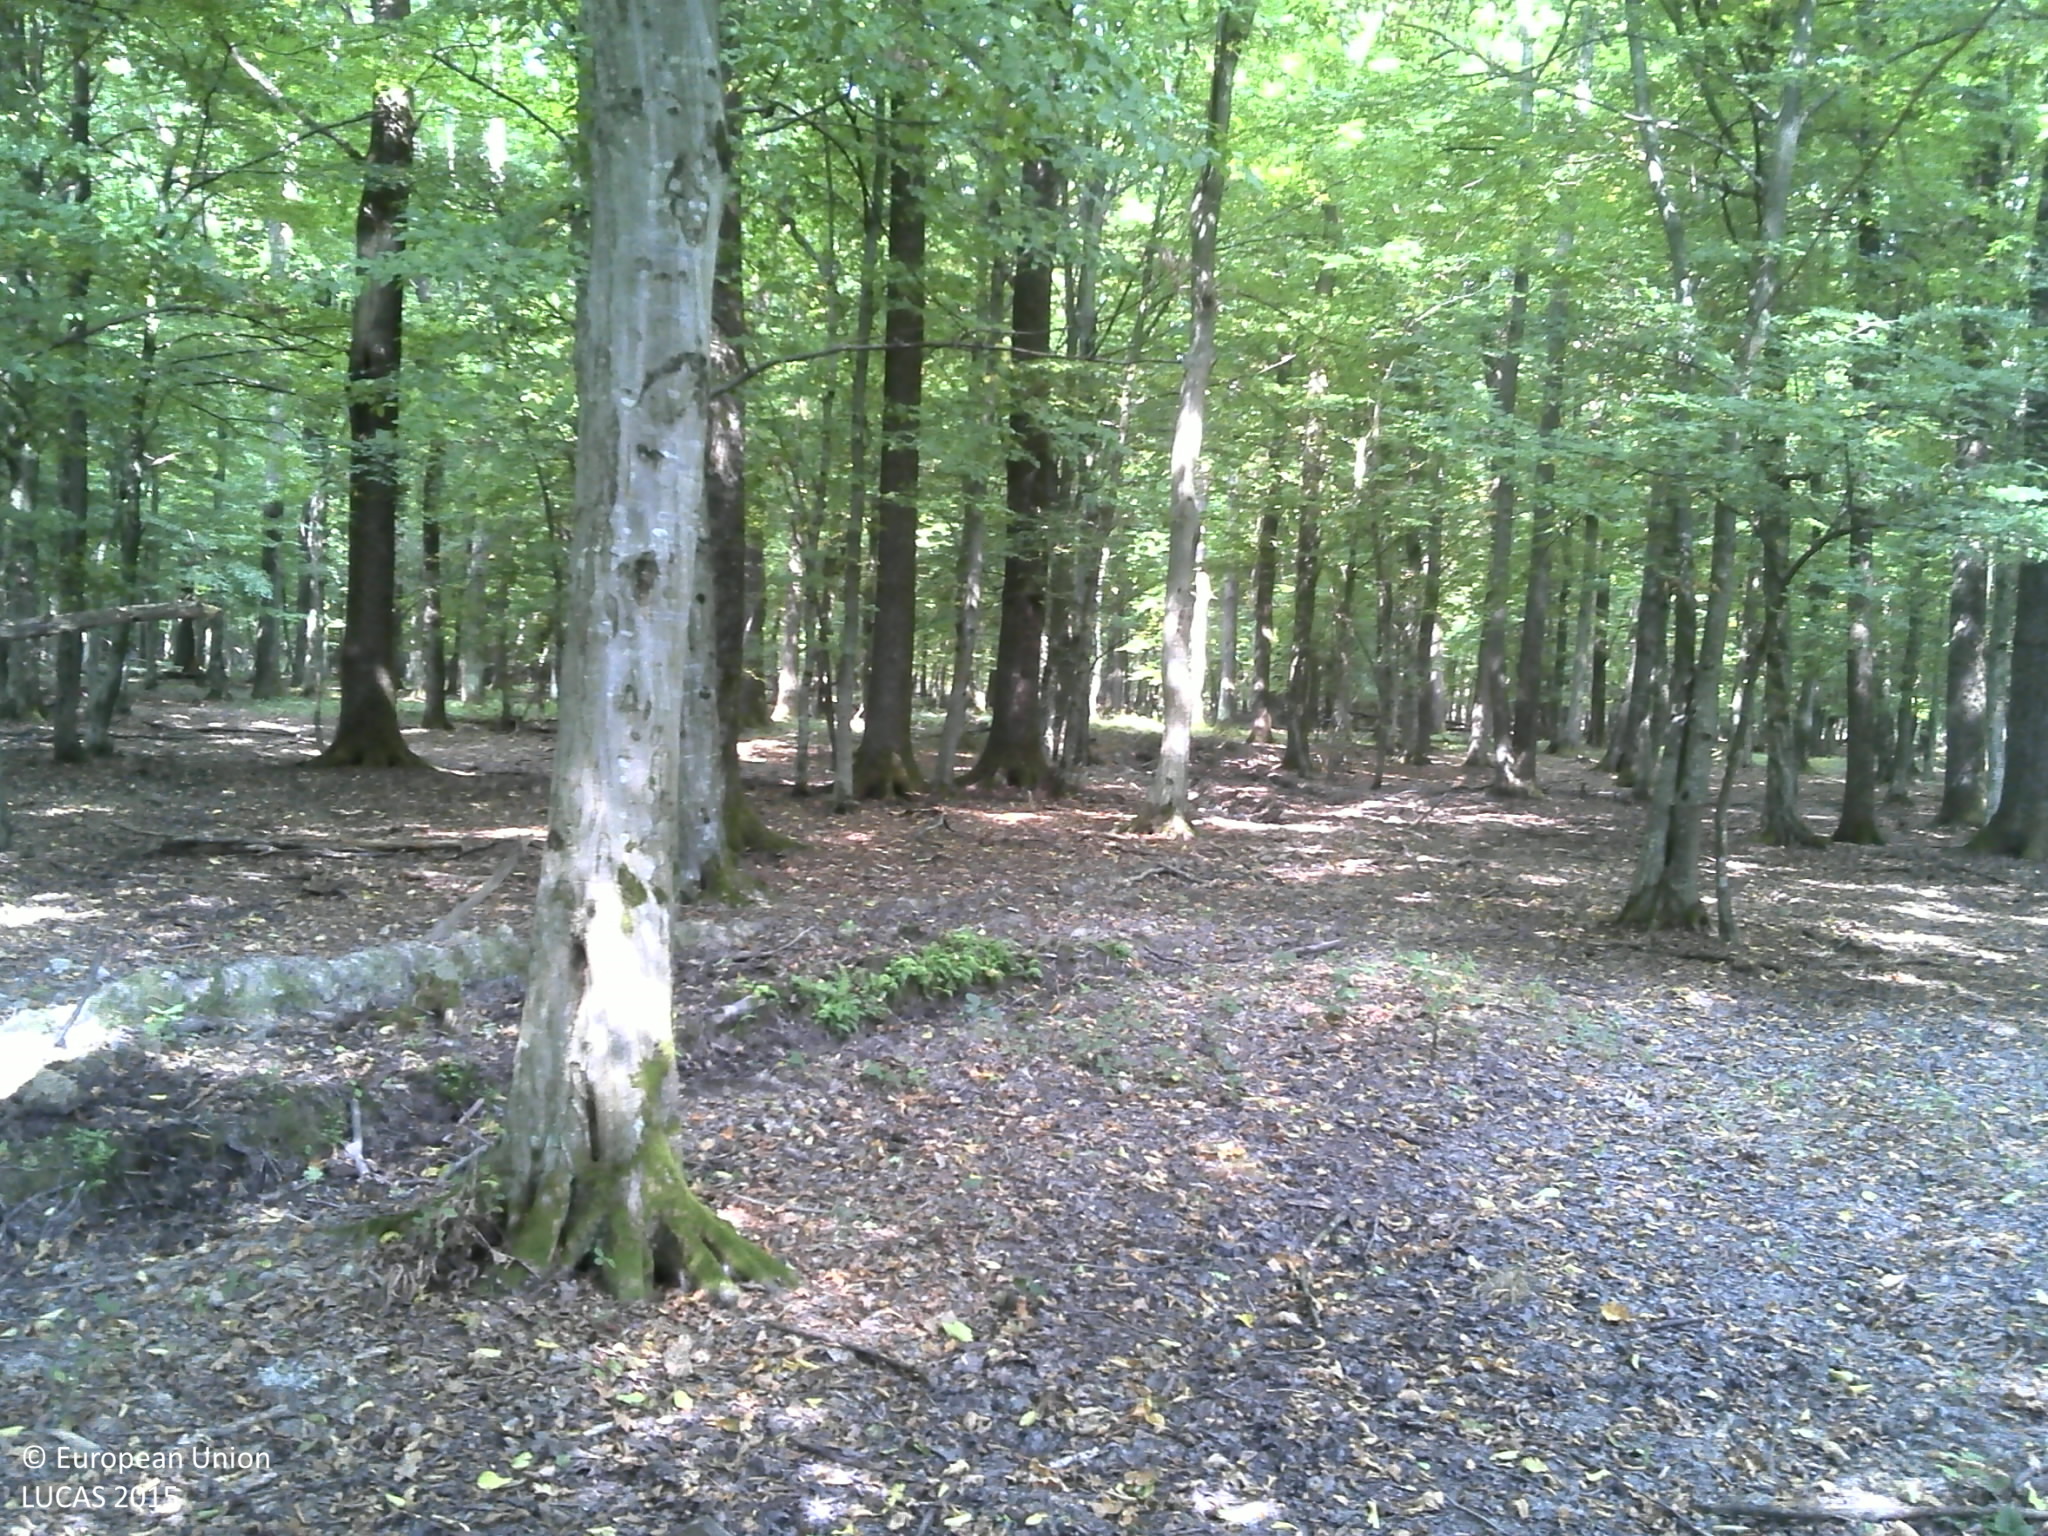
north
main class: Woodland
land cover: Broadleaved woodland
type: mesophytic deciduous forest
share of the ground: > 75 %
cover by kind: broadleaved forest trees 100 %
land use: Forestry
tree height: > 5 m
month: September
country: HR
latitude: 45.6963
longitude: 16.5872
